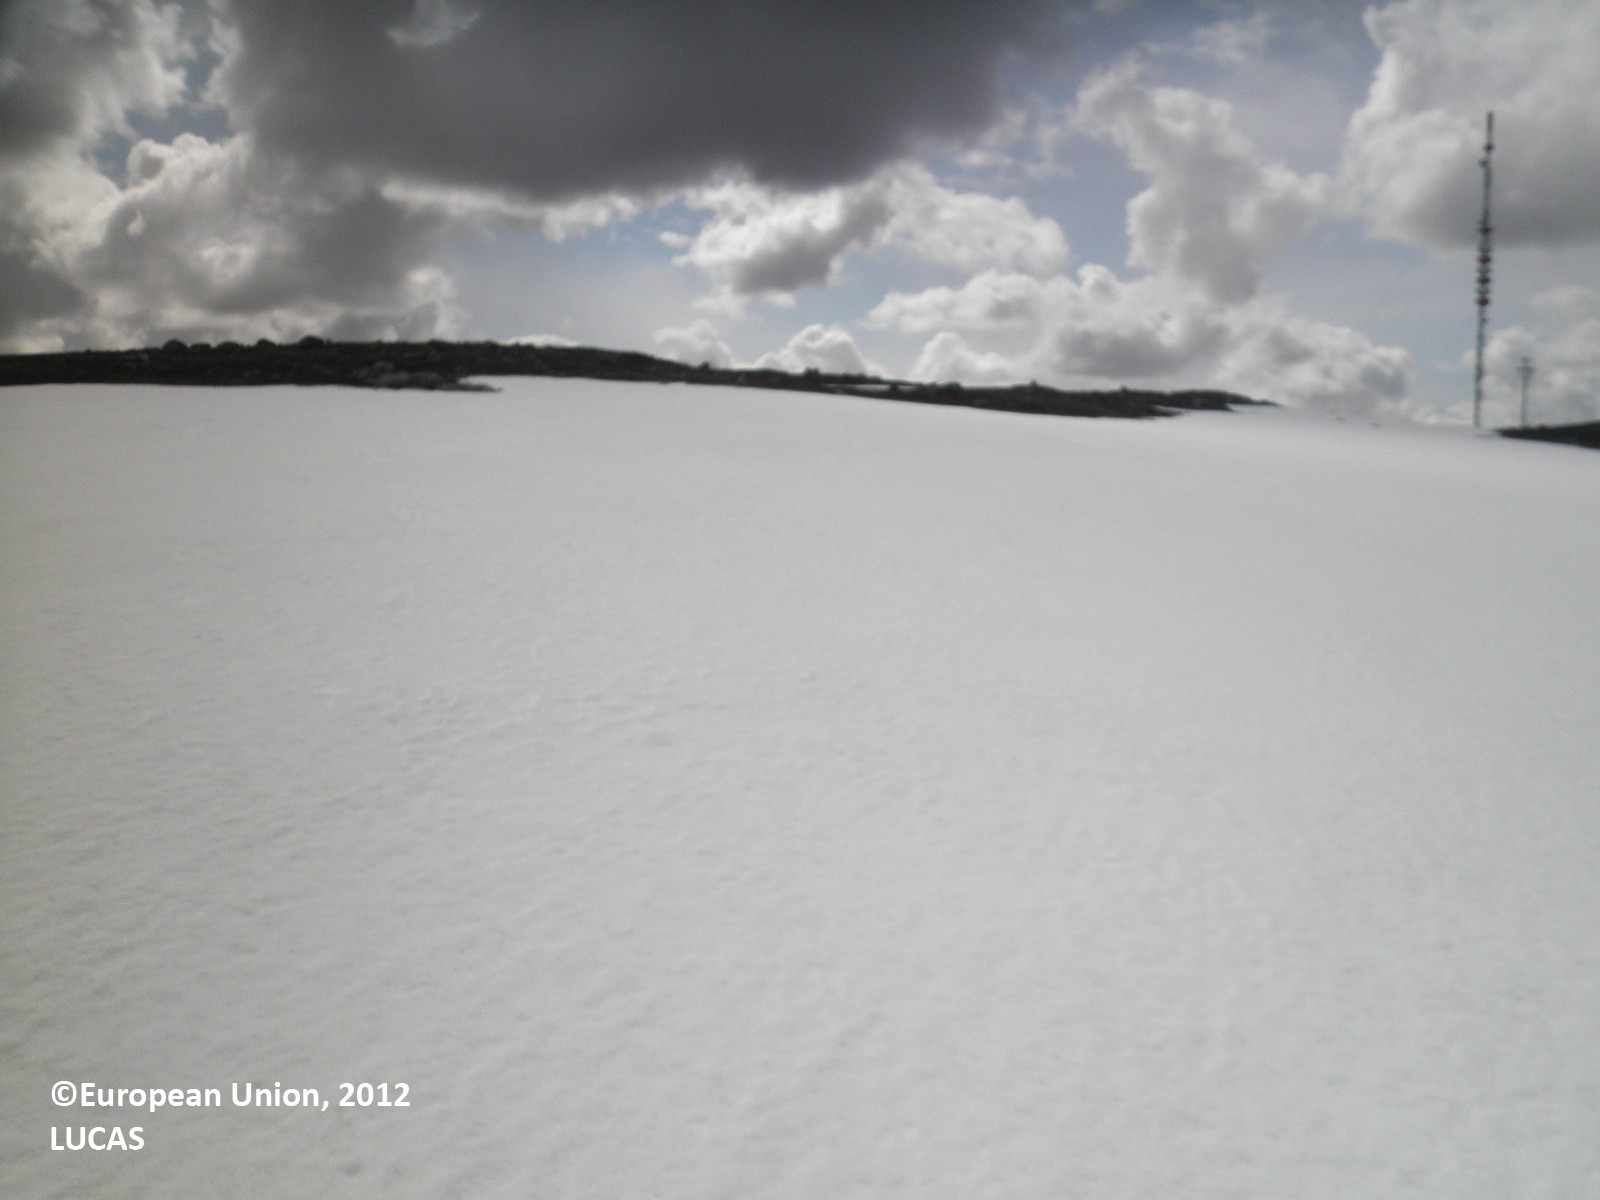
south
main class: Shrubland
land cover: Shrubland without tree cover
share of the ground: > 75 %
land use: Semi-natural and natural areas not in use
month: May
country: FI
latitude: 69.8993
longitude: 27.0673
